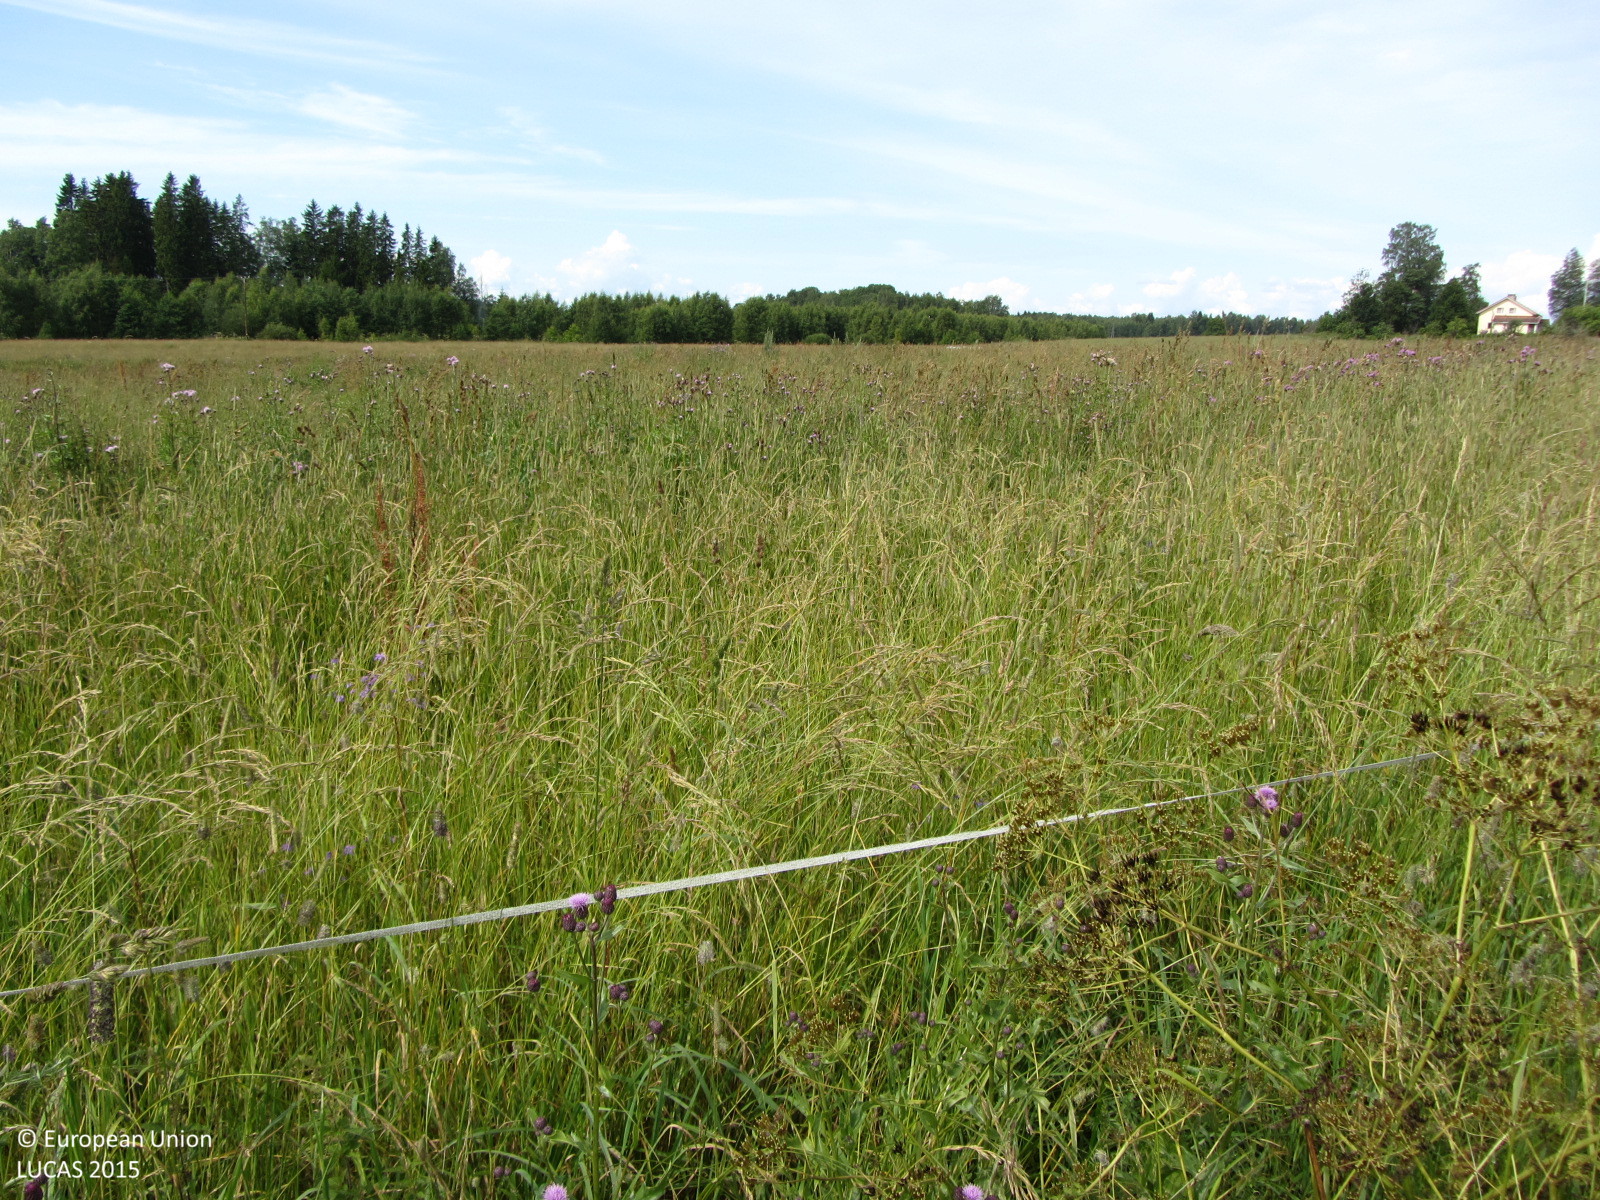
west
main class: Grassland
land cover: Spontaneously vegetated surfaces
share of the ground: > 75 %
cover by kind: herbaceous plants 100 %
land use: Fallow land
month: July
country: FI
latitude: 60.5784
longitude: 24.3557
